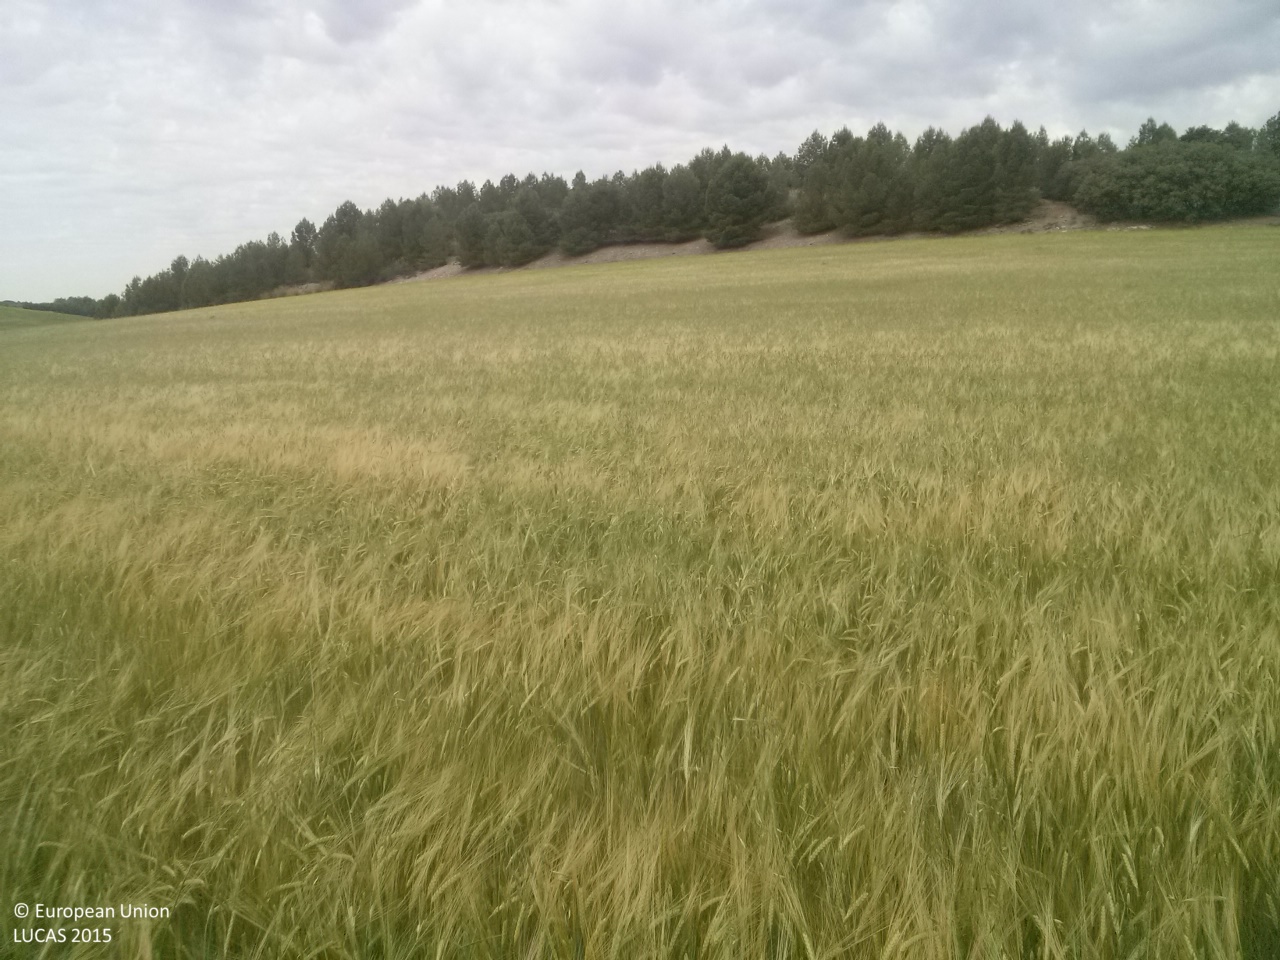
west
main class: Cropland
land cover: Barley
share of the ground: > 75 %
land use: Agriculture (excluding fallow land and kitchen gardens)
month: May
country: ES
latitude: 40.0692
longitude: -2.9094
